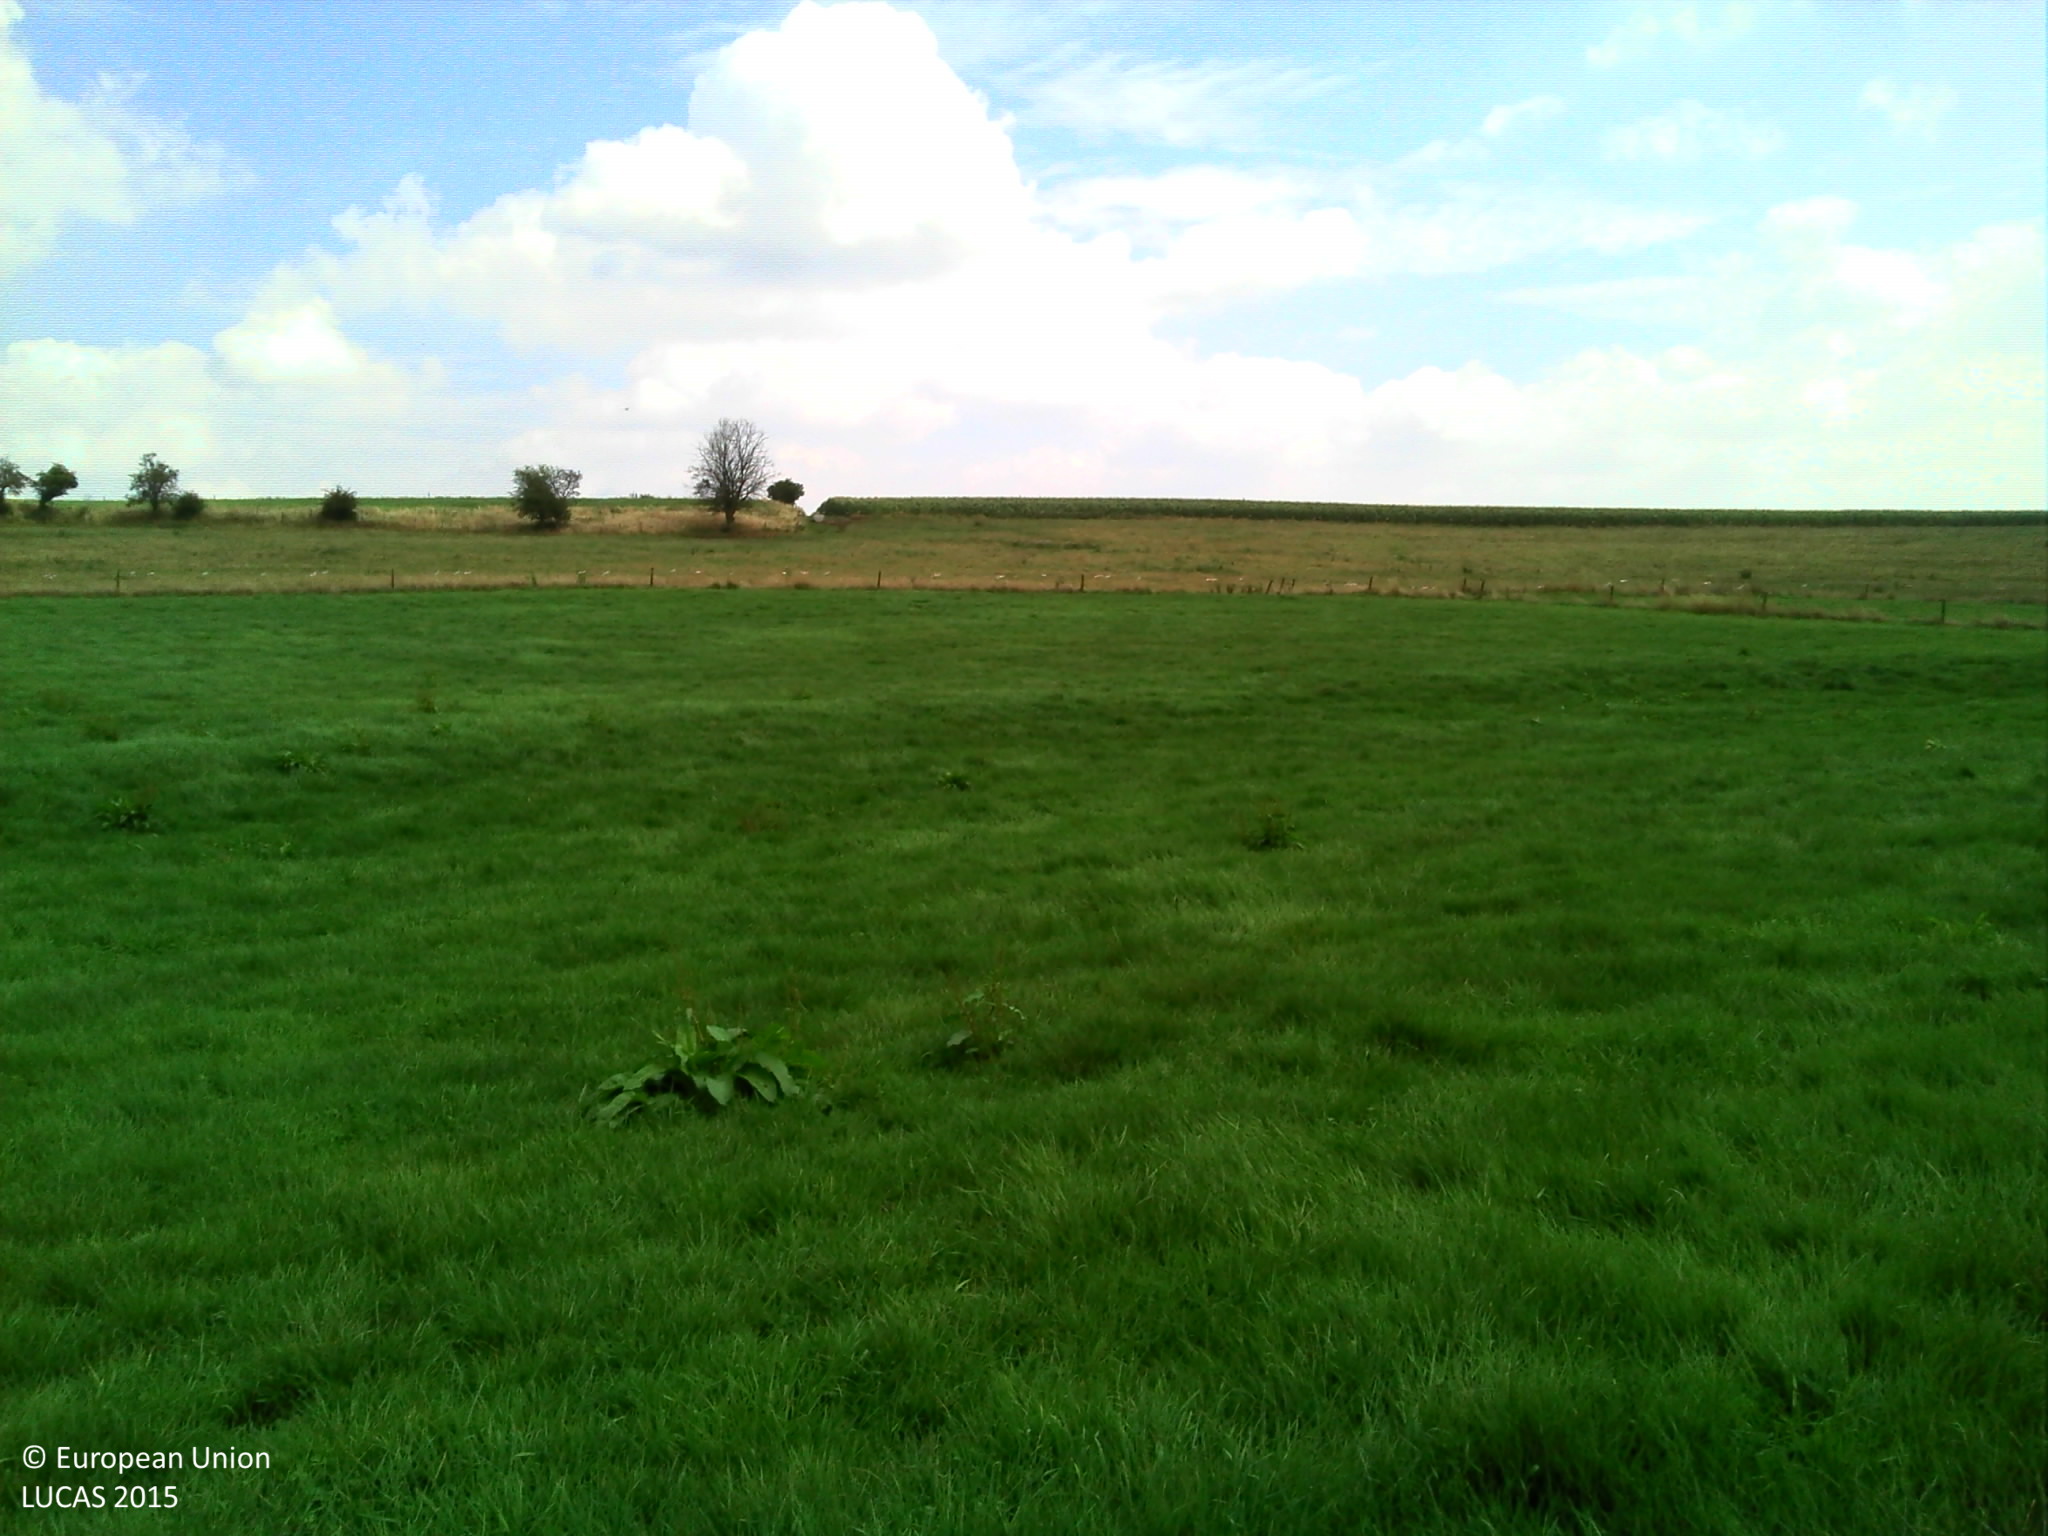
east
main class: Grassland
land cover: Grassland without tree/shrub cover
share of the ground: > 75 %
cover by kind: herbaceous plants 100 %
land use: Agriculture (excluding fallow land and kitchen gardens)
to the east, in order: Grassland without tree/shrub cover; Fences; Grassland without tree/shrub cover; Fences; Grass margins; Maize
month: August
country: BE
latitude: 50.7671
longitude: 2.7718
